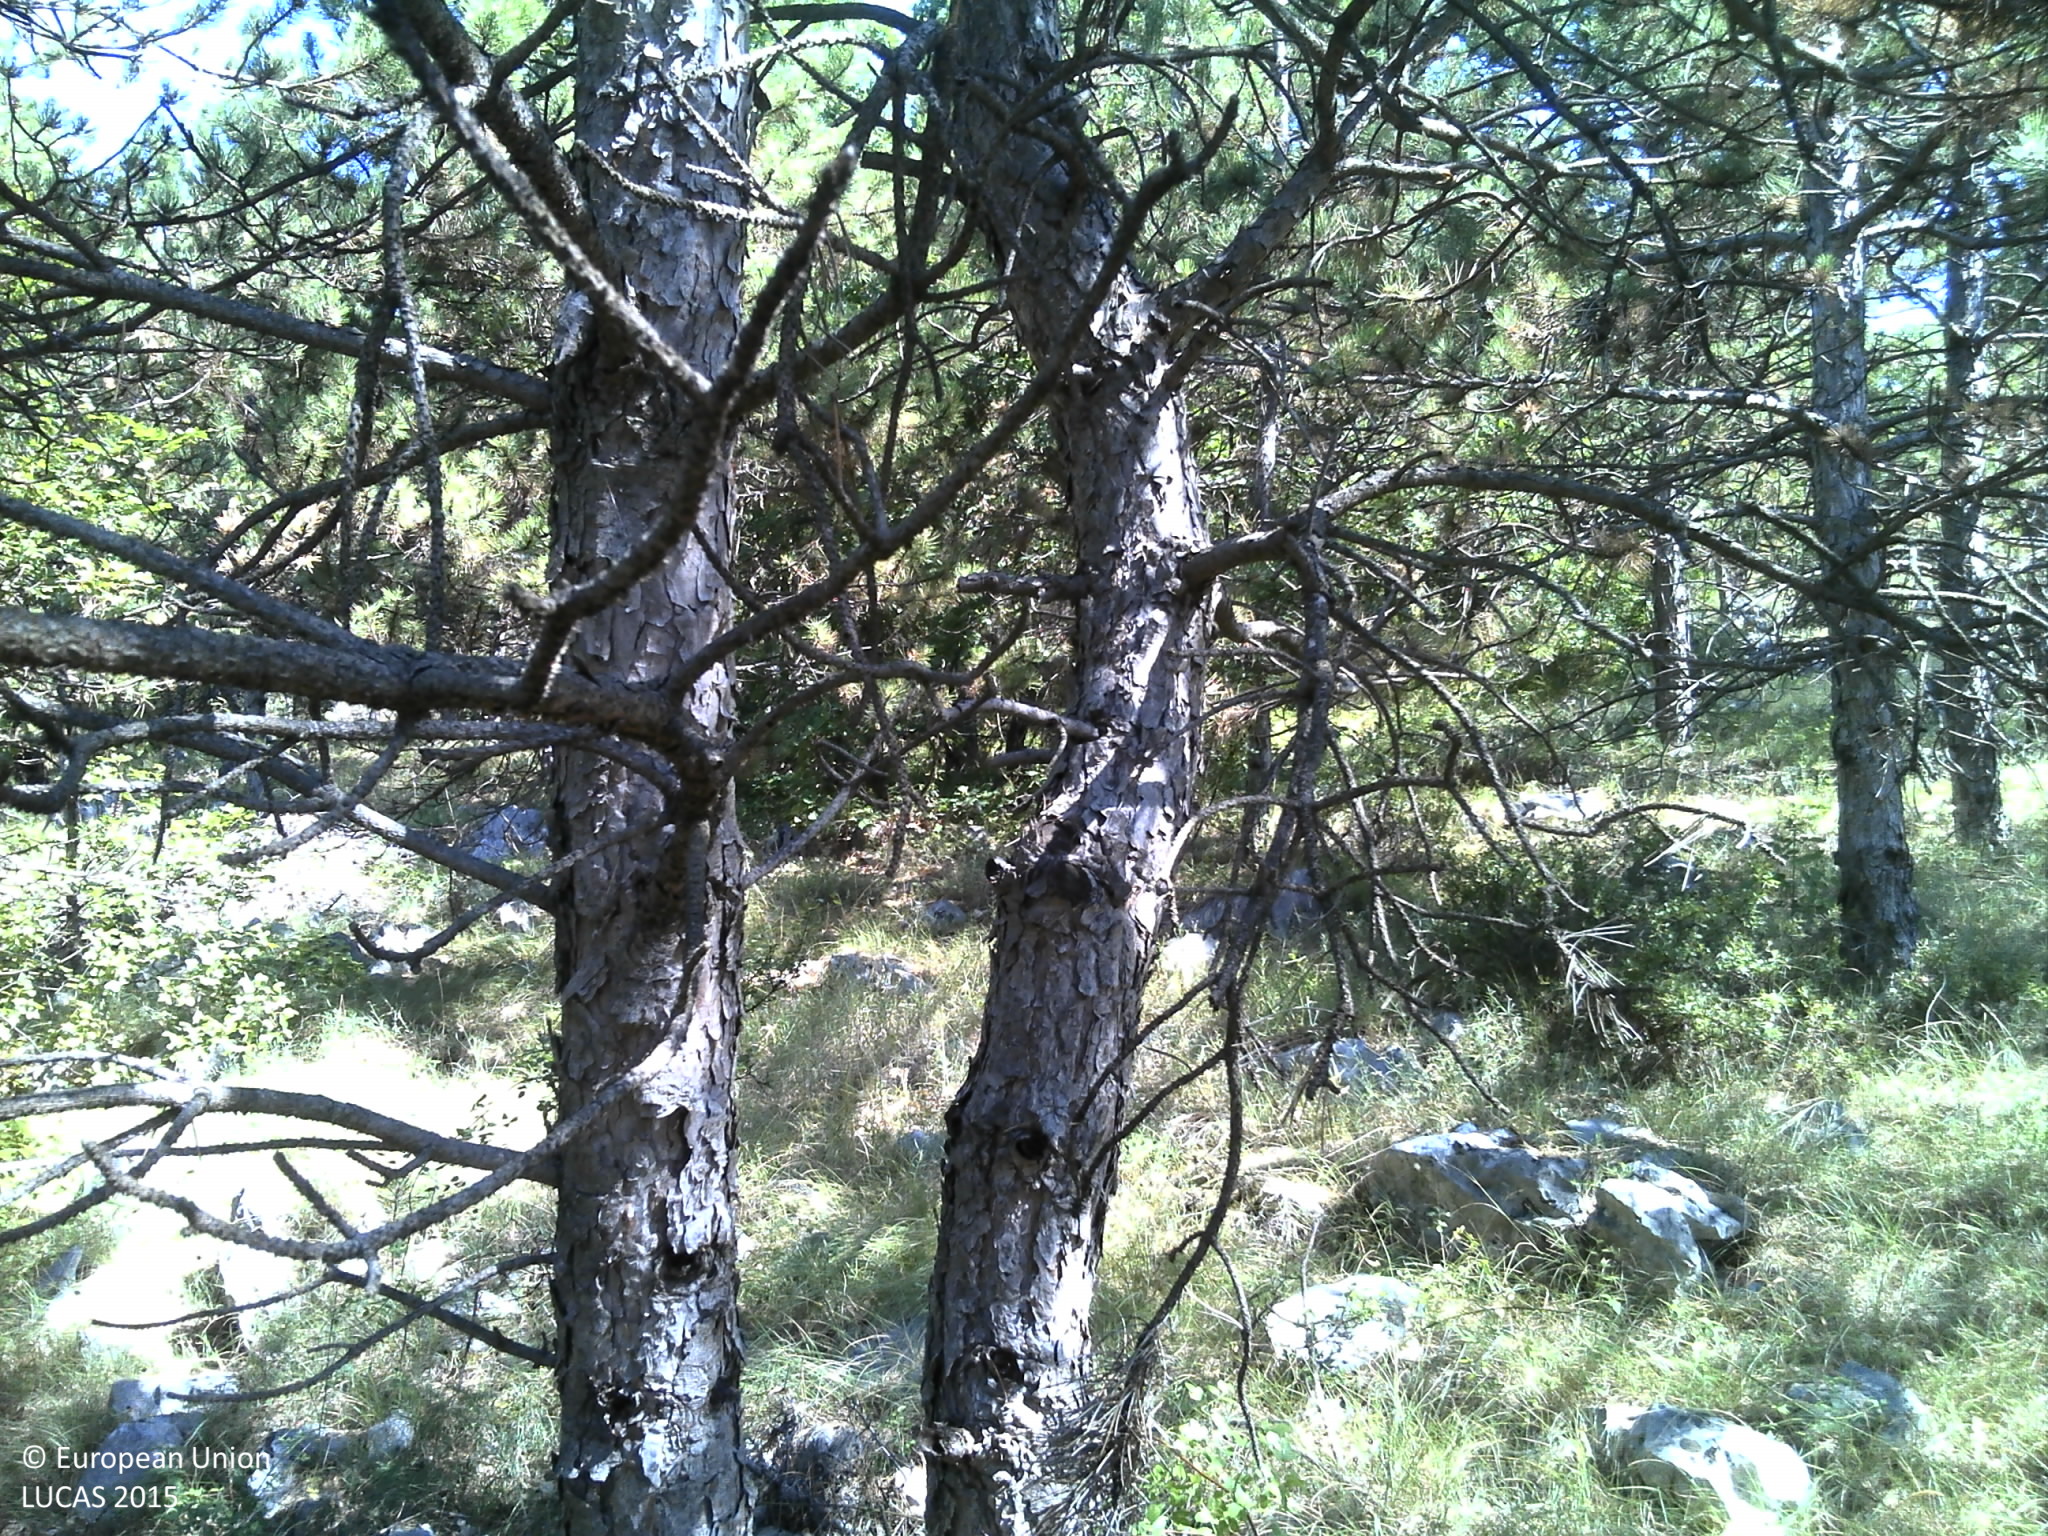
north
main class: Woodland
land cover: Pine dominated coniferous woodland
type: coniferous forest of the mediterranean region
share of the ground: > 75 %
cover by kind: coniferous forest trees 80 %, shrubs 10 %, herbaceous plants 5 %, consolidated bare surface 5 %
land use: Semi-natural and natural areas not in use
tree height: > 5 m
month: July
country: HR
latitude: 43.4684
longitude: 17.1737
